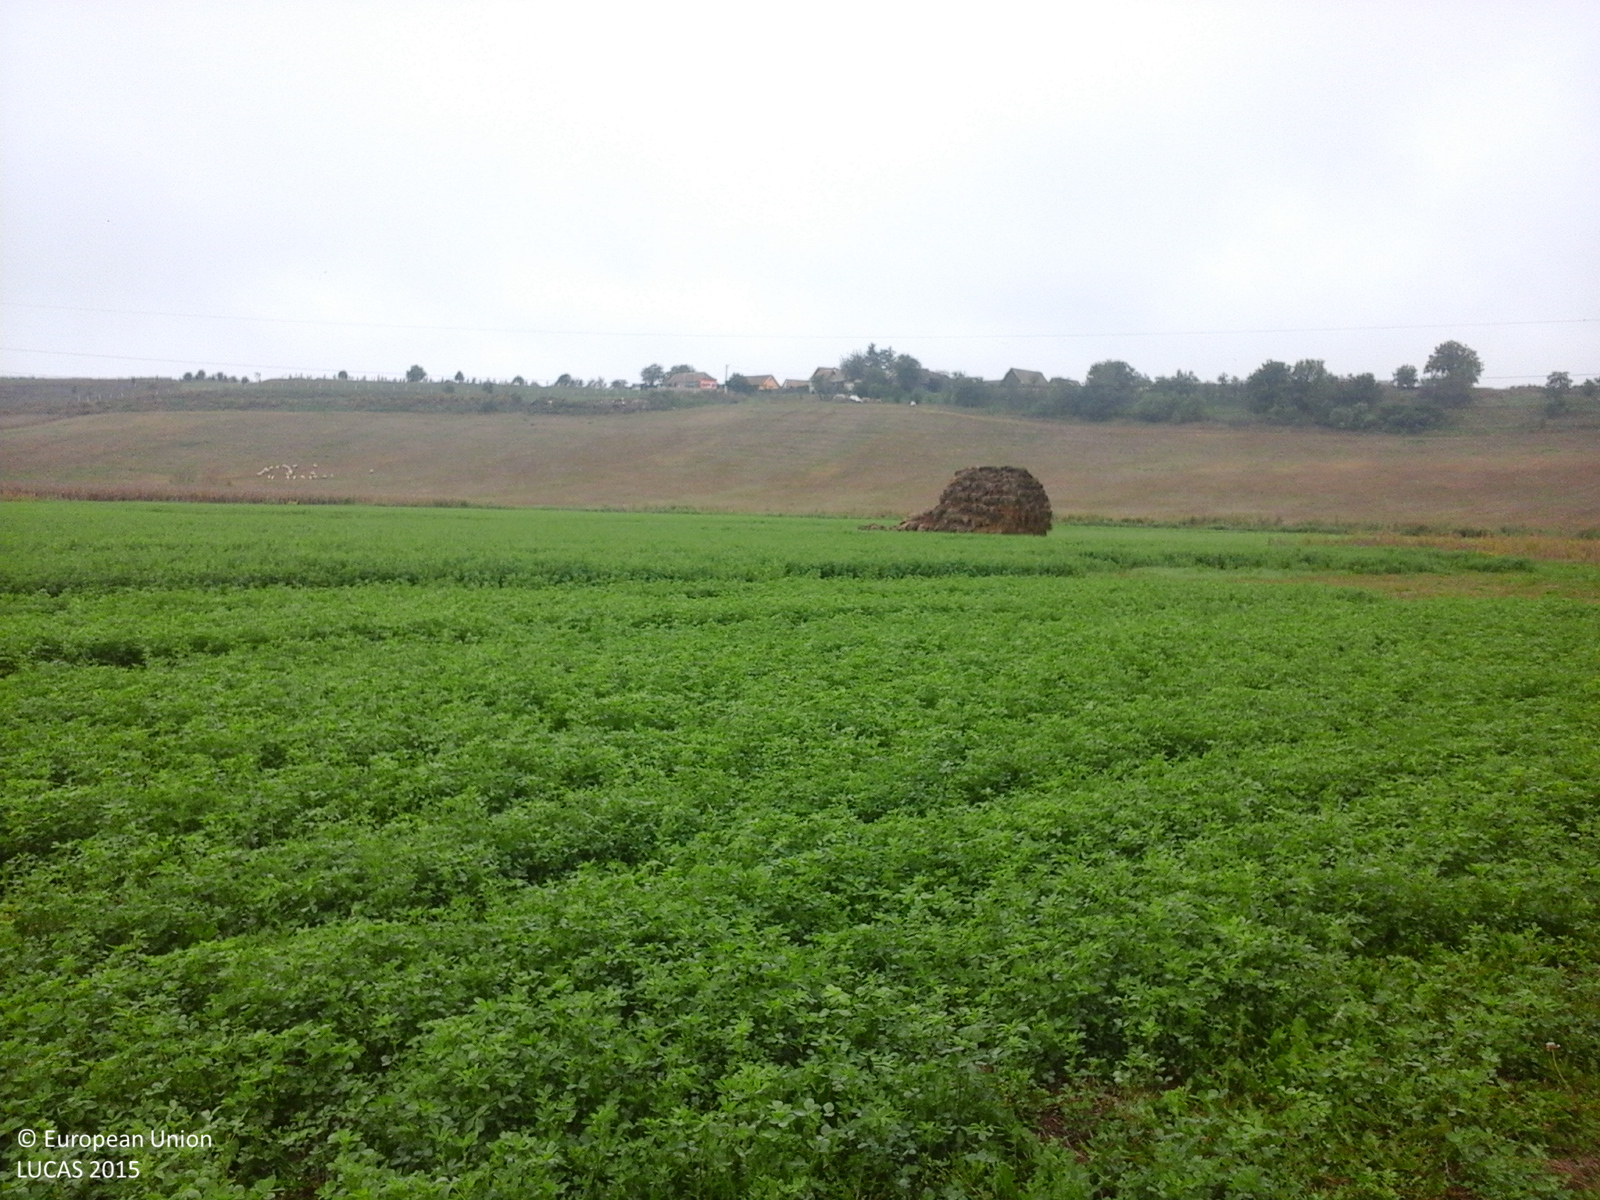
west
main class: Cropland
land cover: Maize
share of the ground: > 75 %
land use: Agriculture (excluding fallow land and kitchen gardens)
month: October
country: RO
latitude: 46.2419
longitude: 24.1759
